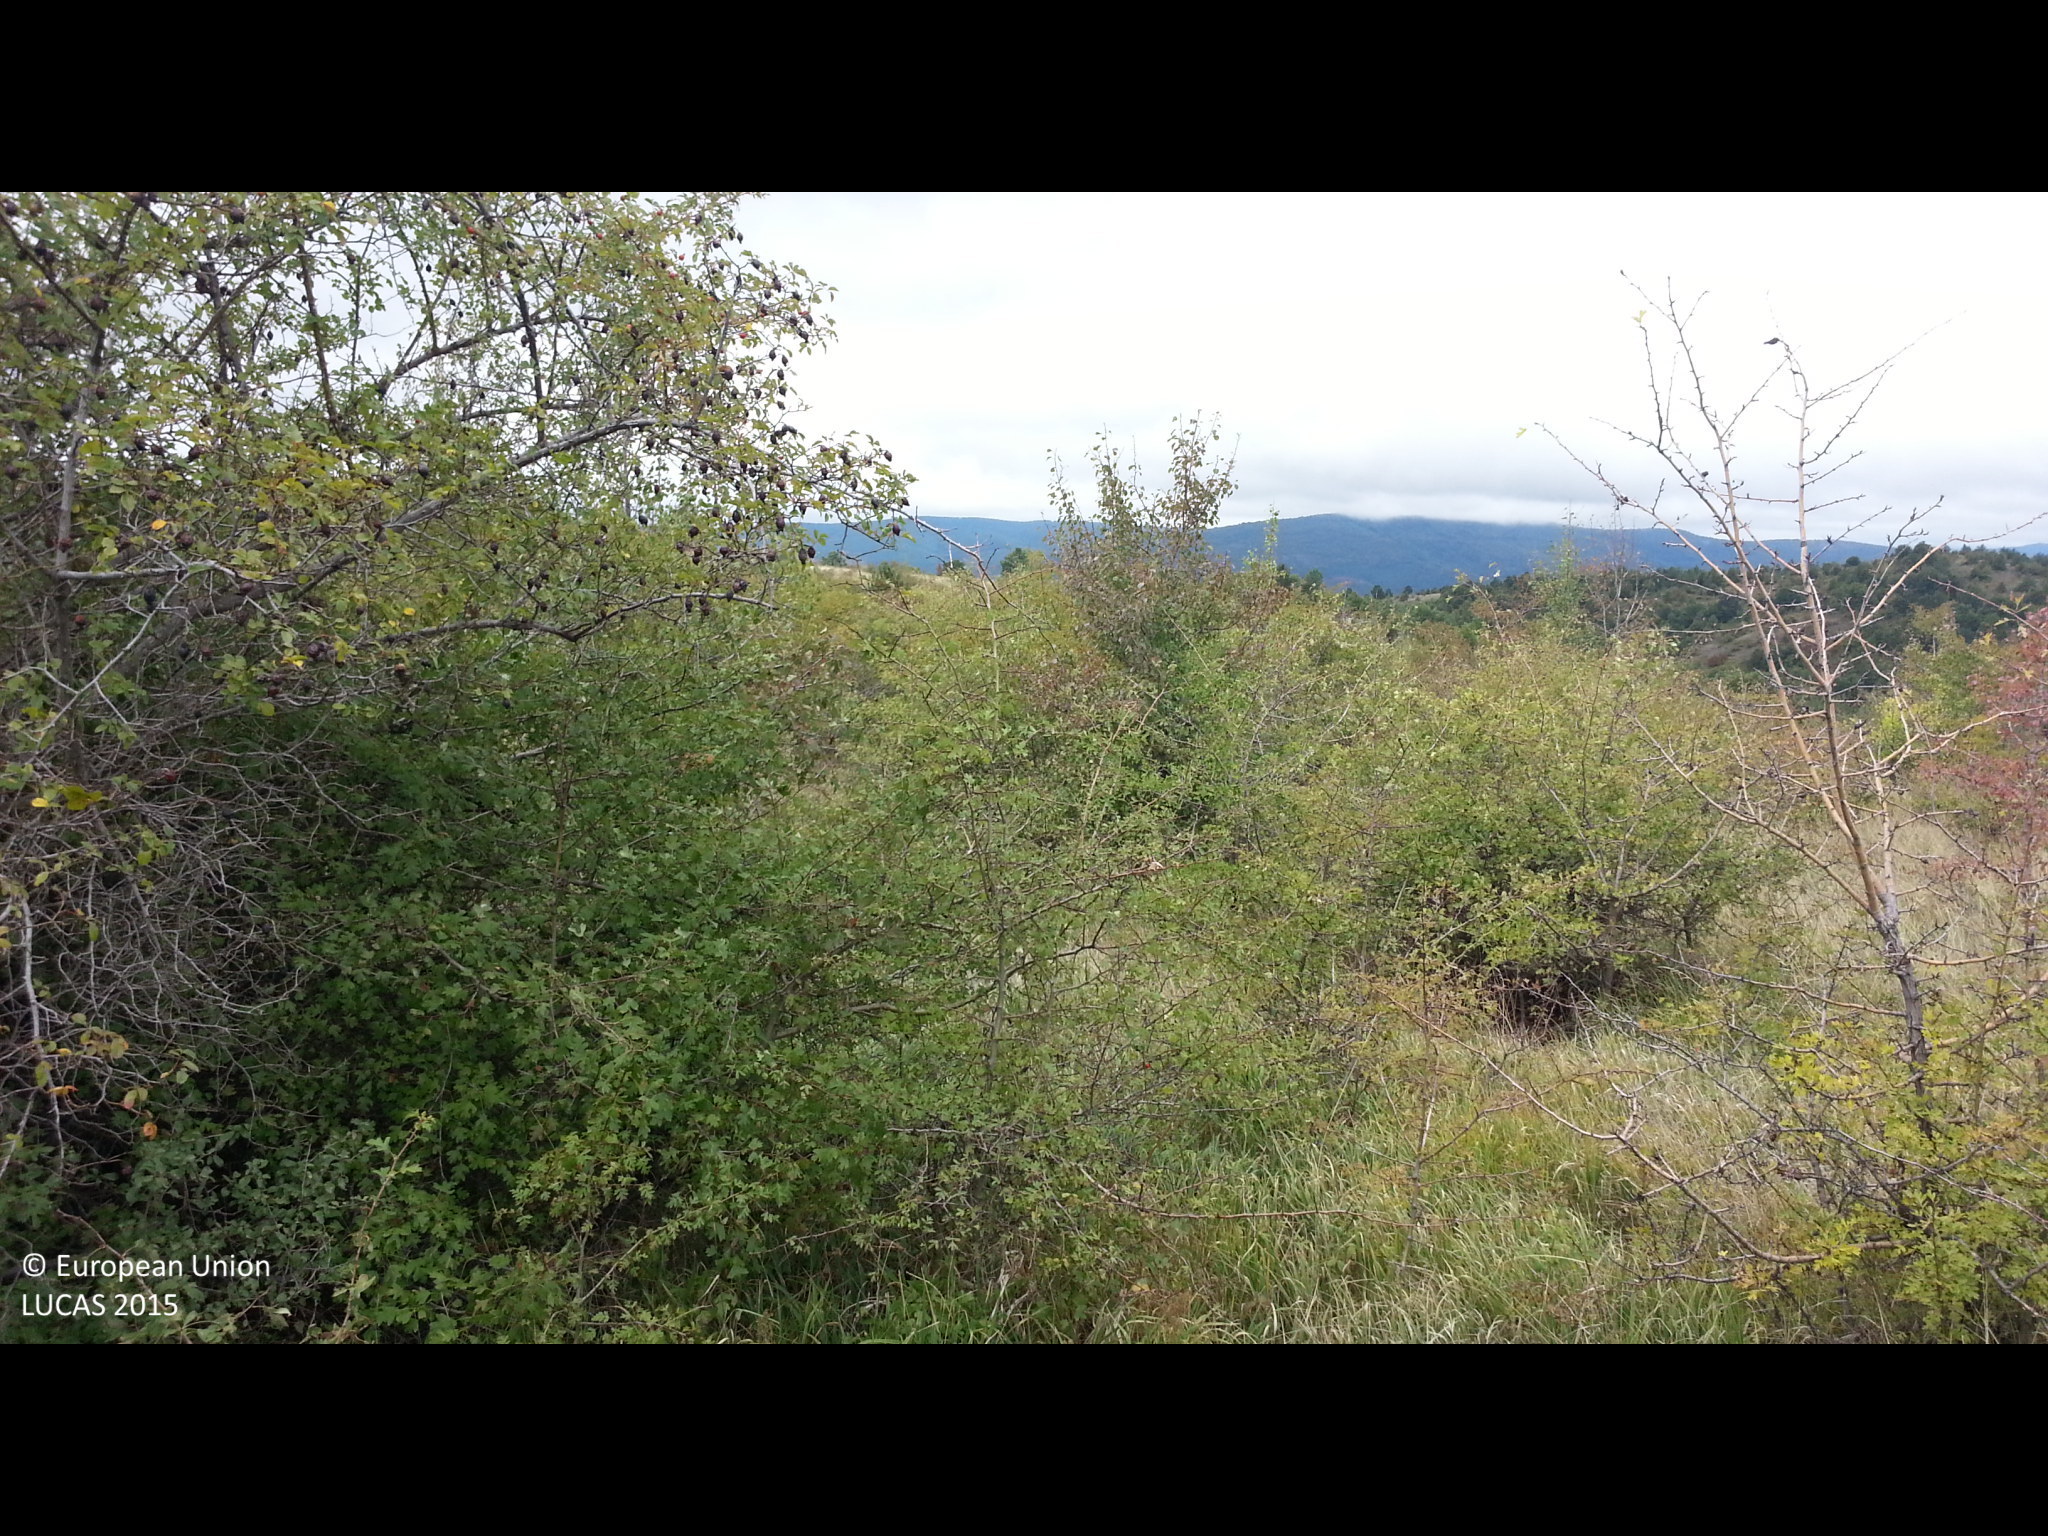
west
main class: Grassland
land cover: Grassland with sparse tree/shrub cover
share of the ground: > 75 %
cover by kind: herbaceous plants 90 %, broadleaved forest trees 5 %, shrubs 5 %
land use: Abandoned areas
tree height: < 5 m
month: September
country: BG
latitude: 42.5975
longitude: 22.8603
